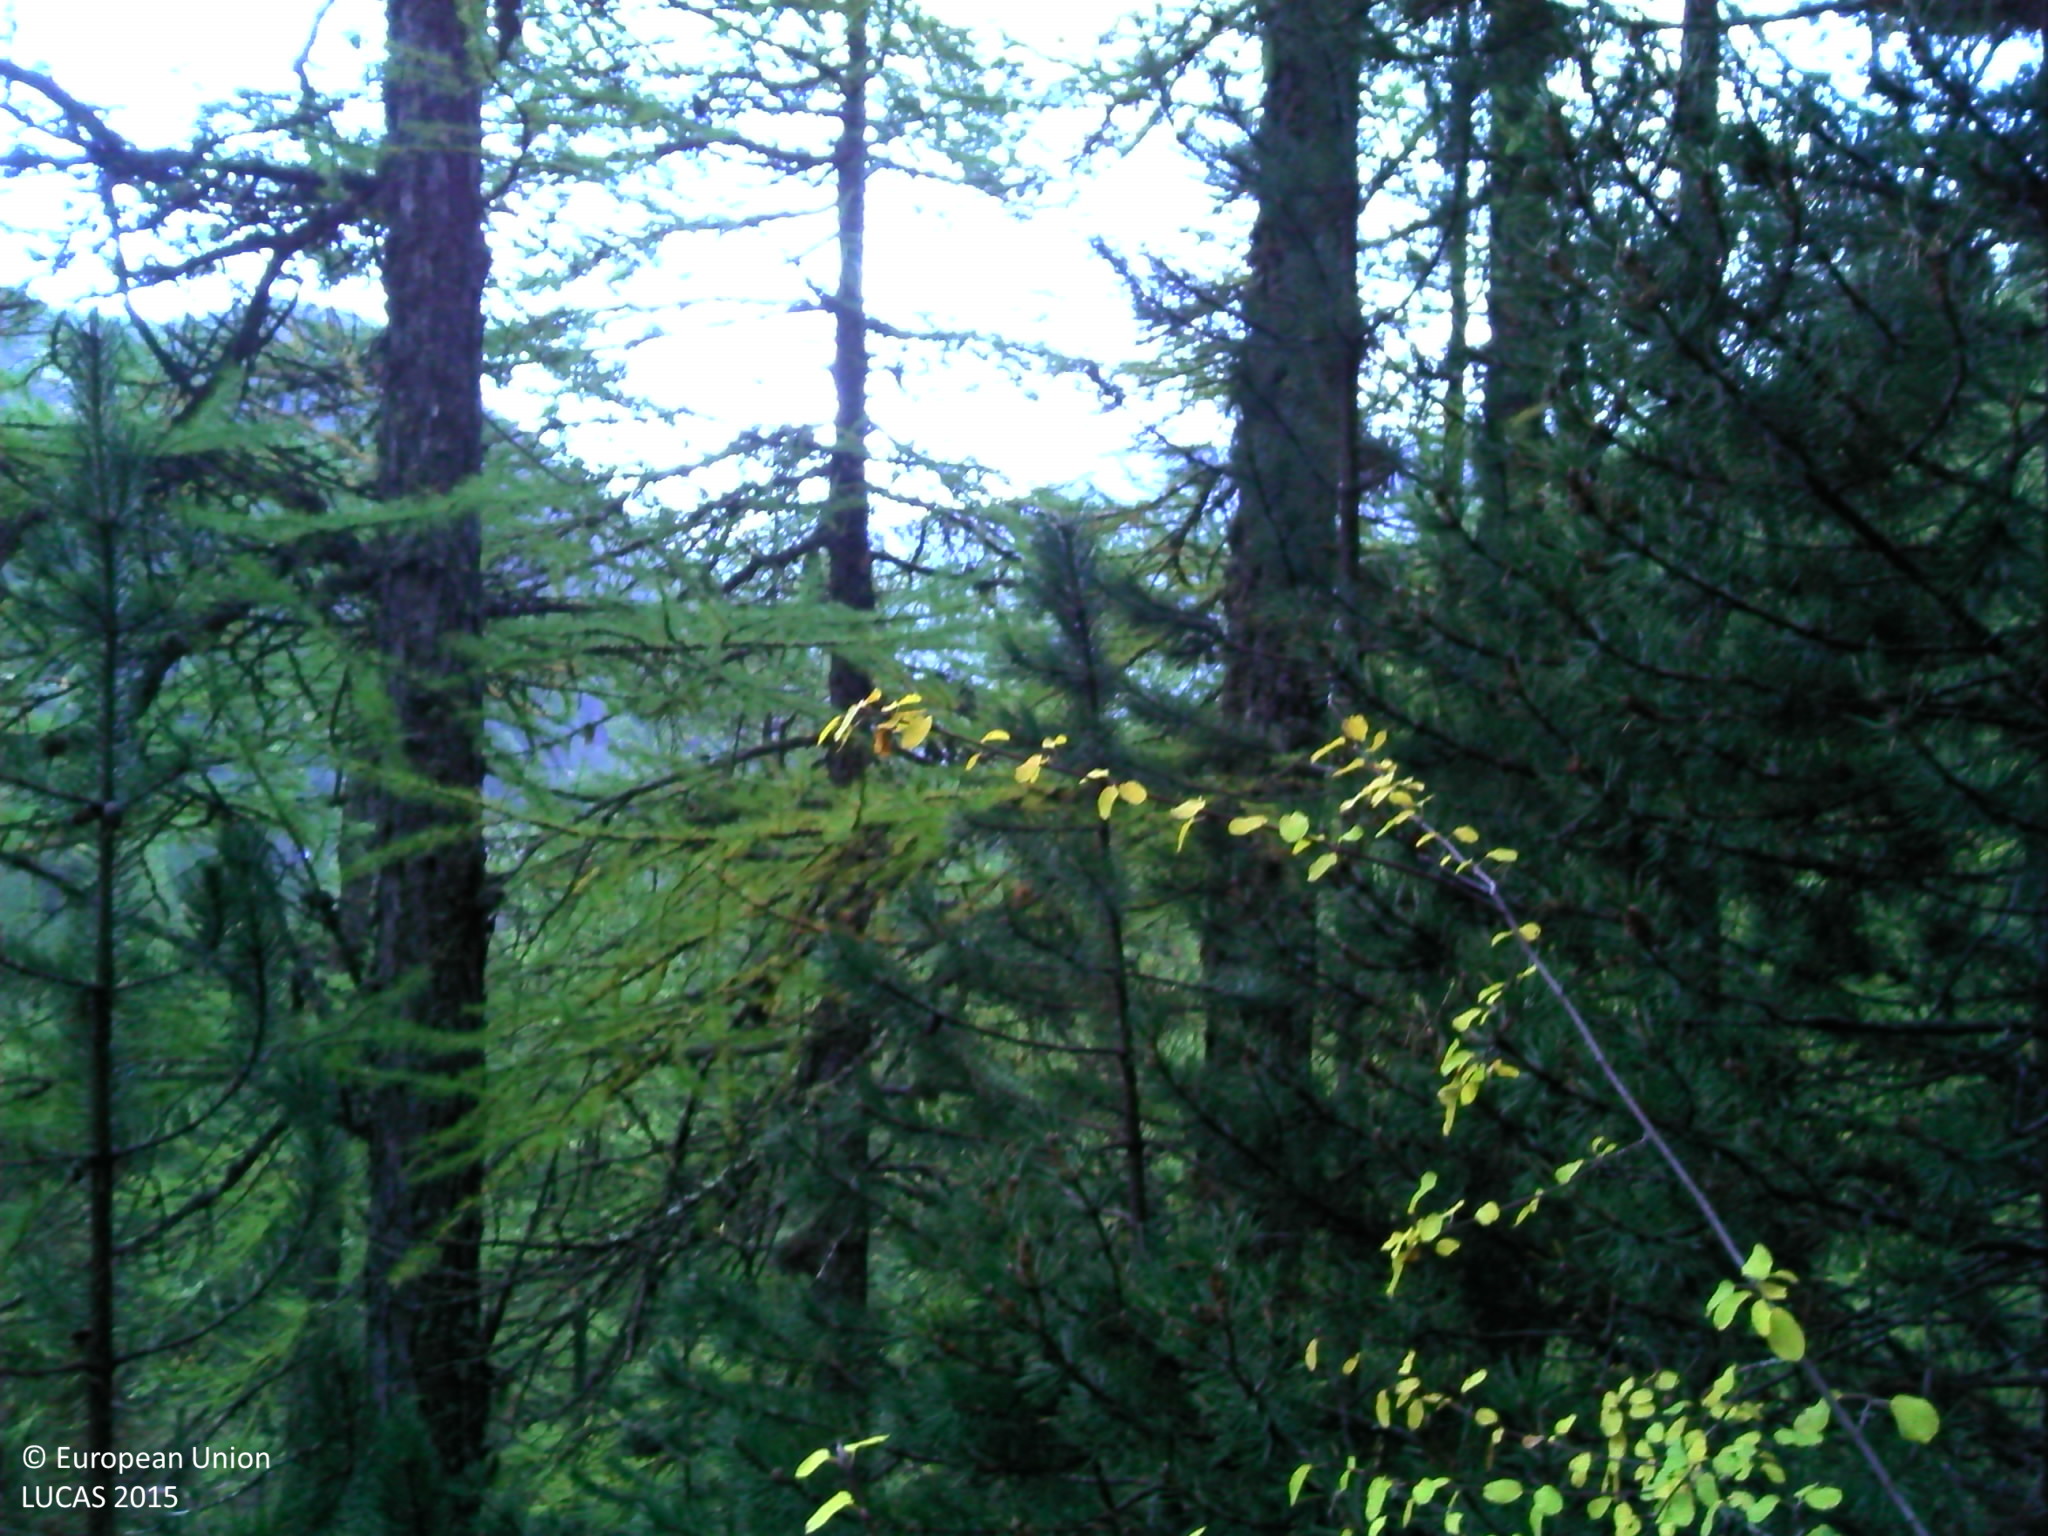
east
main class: Woodland
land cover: Pine dominated coniferous woodland
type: alpine coniferous forest
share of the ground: > 75 %
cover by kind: coniferous forest trees 70 %, shrubs 10 %, herbaceous plants 10 %, unconsolidated bare surface 10 %
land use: Forestry
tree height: > 5 m
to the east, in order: Pine dominated coniferous woodland; Tracks; Pine dominated coniferous woodland; Shrubland with sparse tree cover; Inland fresh running water; Shrubland with sparse tree cover; Pine dominated coniferous woodland; Tracks; Pine dominated coniferous woodland
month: October
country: FR
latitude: 44.7512
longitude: 6.7594
